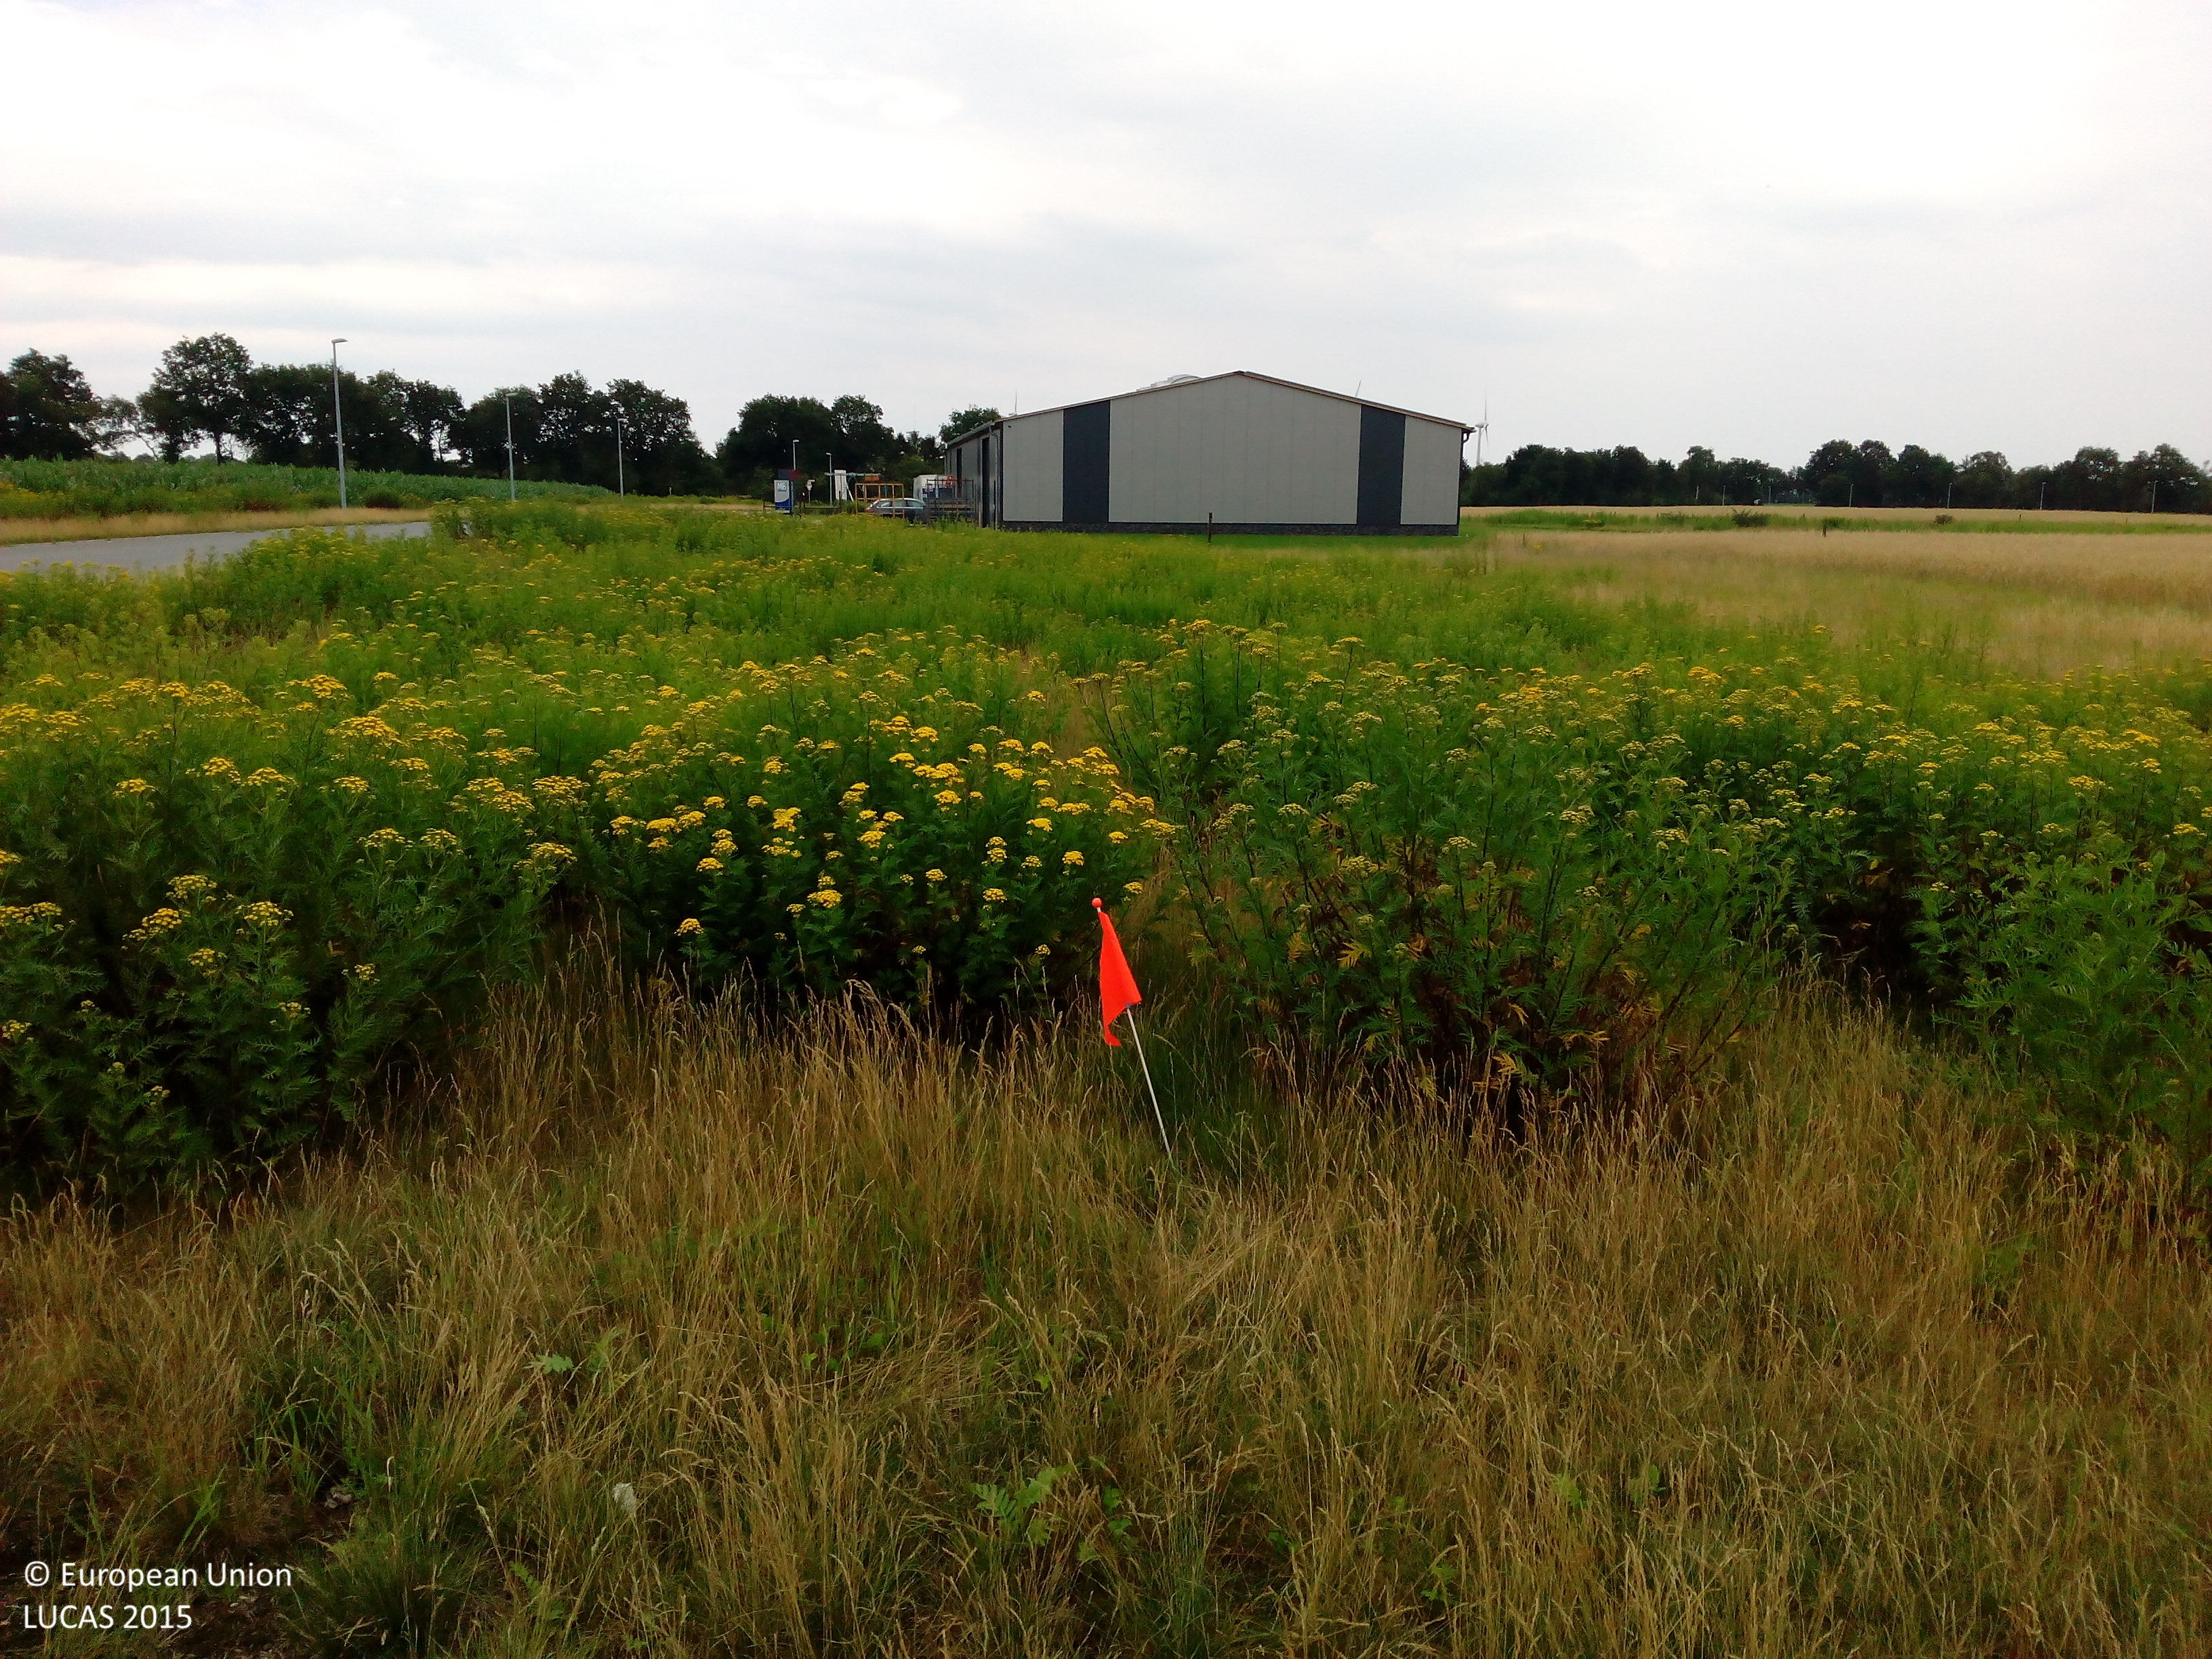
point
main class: Grassland
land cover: Spontaneously vegetated surfaces
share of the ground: > 75 %
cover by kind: herbaceous plants 100 %
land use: Fallow land
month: July
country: DE
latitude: 52.9892
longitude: 7.9597
